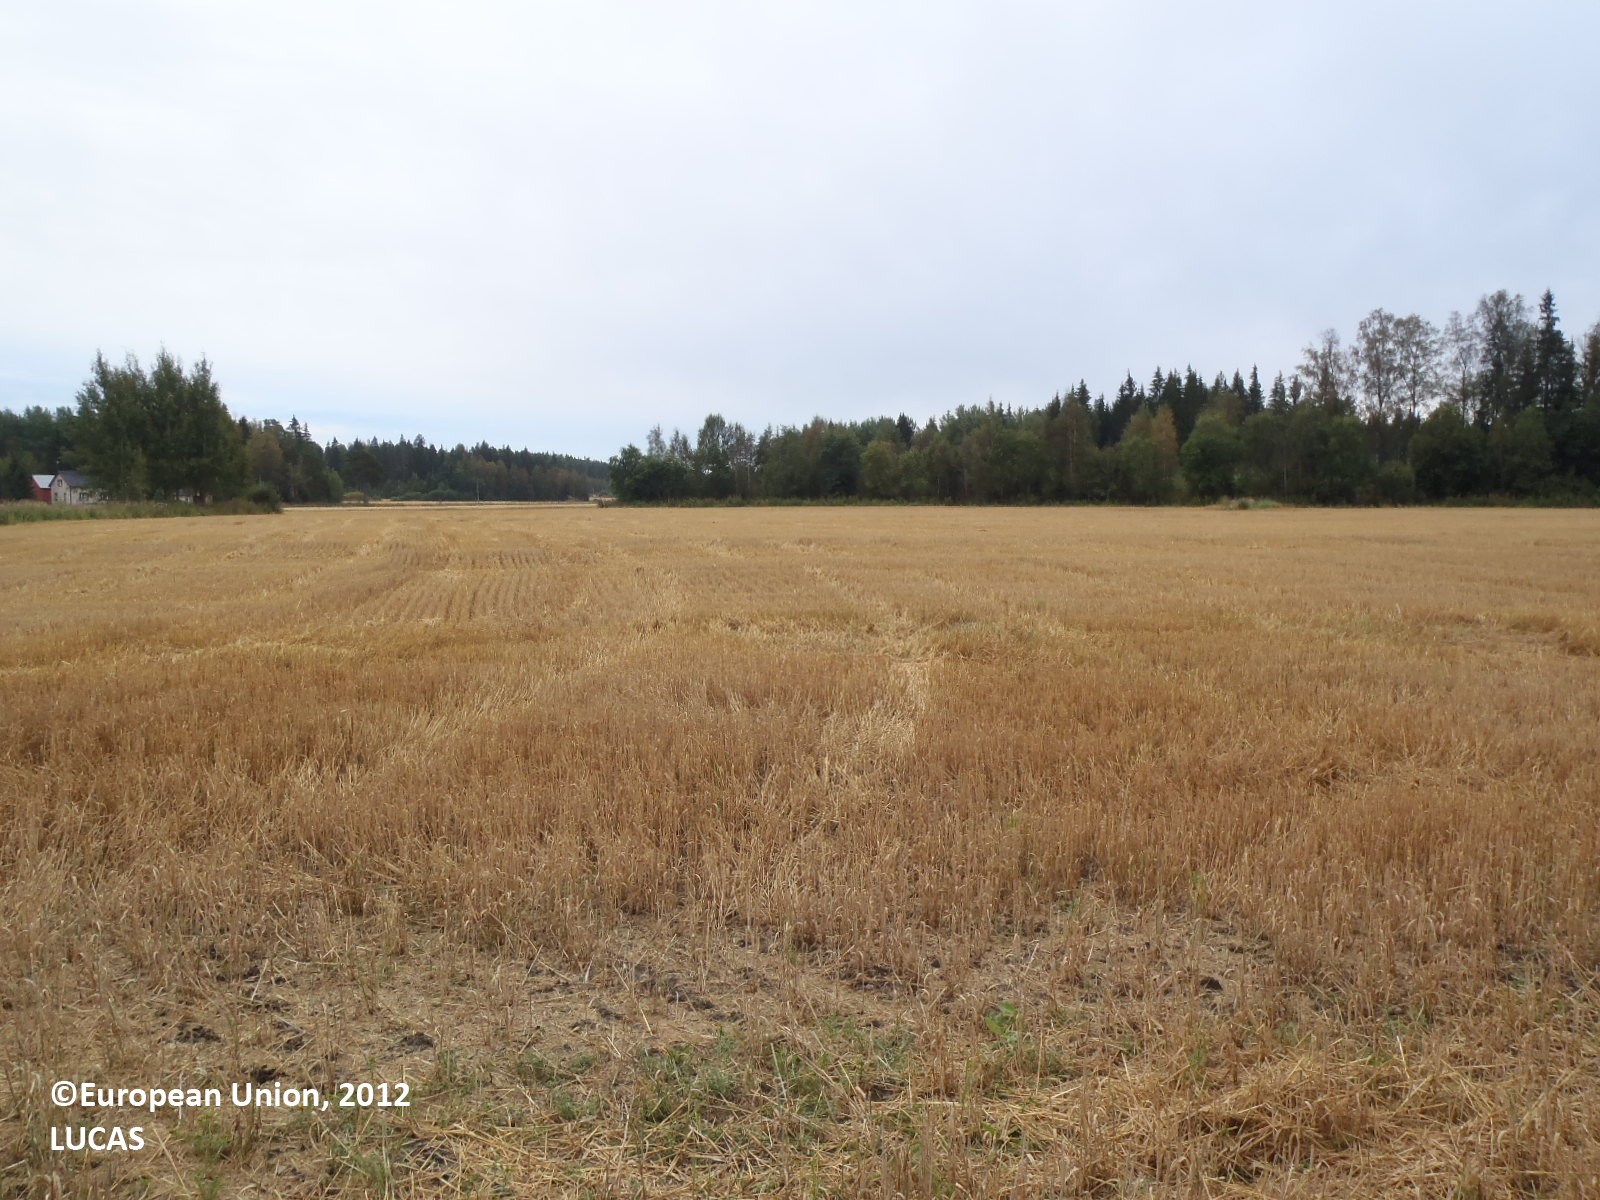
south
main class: Cropland
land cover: Barley
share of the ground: > 75 %
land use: Agriculture (excluding fallow land and kitchen gardens)
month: August
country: FI
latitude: 60.8754
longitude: 21.9401
